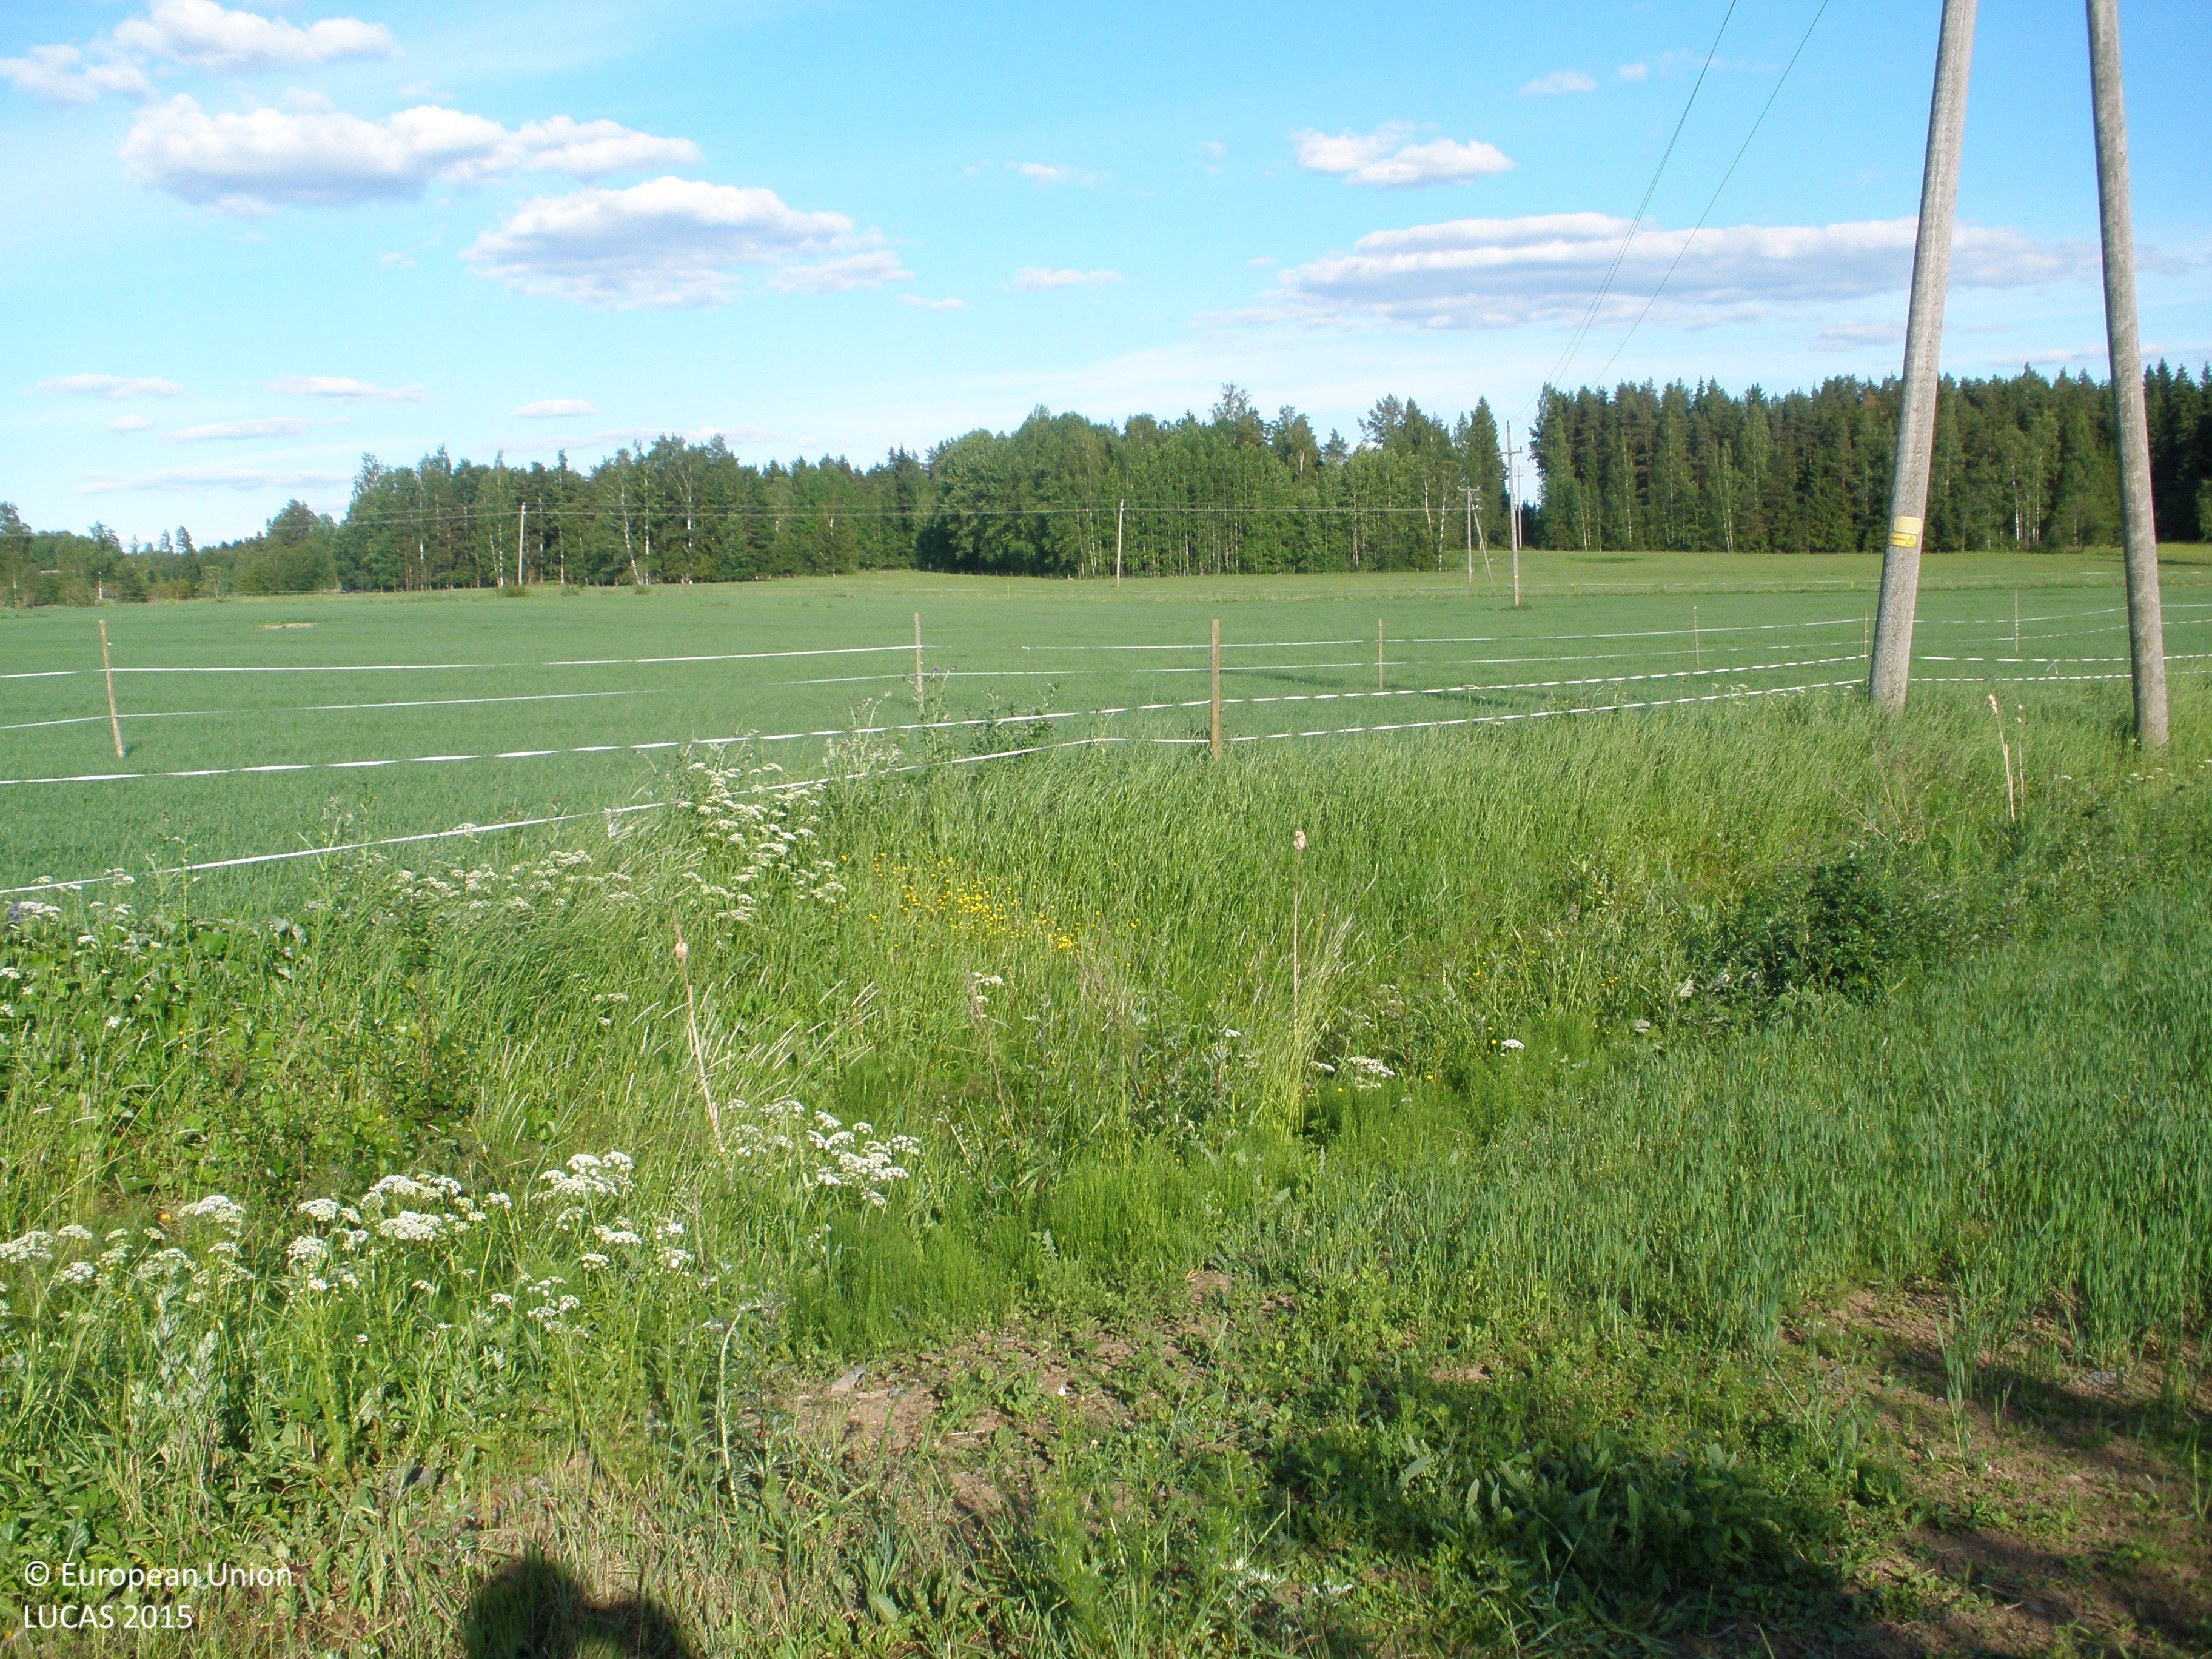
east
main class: Cropland
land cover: Common wheat
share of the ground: > 75 %
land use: Agriculture (excluding fallow land and kitchen gardens)
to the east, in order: Common wheat; Shruby margins; Ditches and canals; Shruby margins; Fences; Grassland without tree/shrub cover; Fences; Oats; Electric lines; Oats; Electric lines; Oats; Ditches and canals; Fences; Temporary grasslands; Fences; Ditches and canals; Other mixed woodland
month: July
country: FI
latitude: 61.1704
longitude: 23.9399
